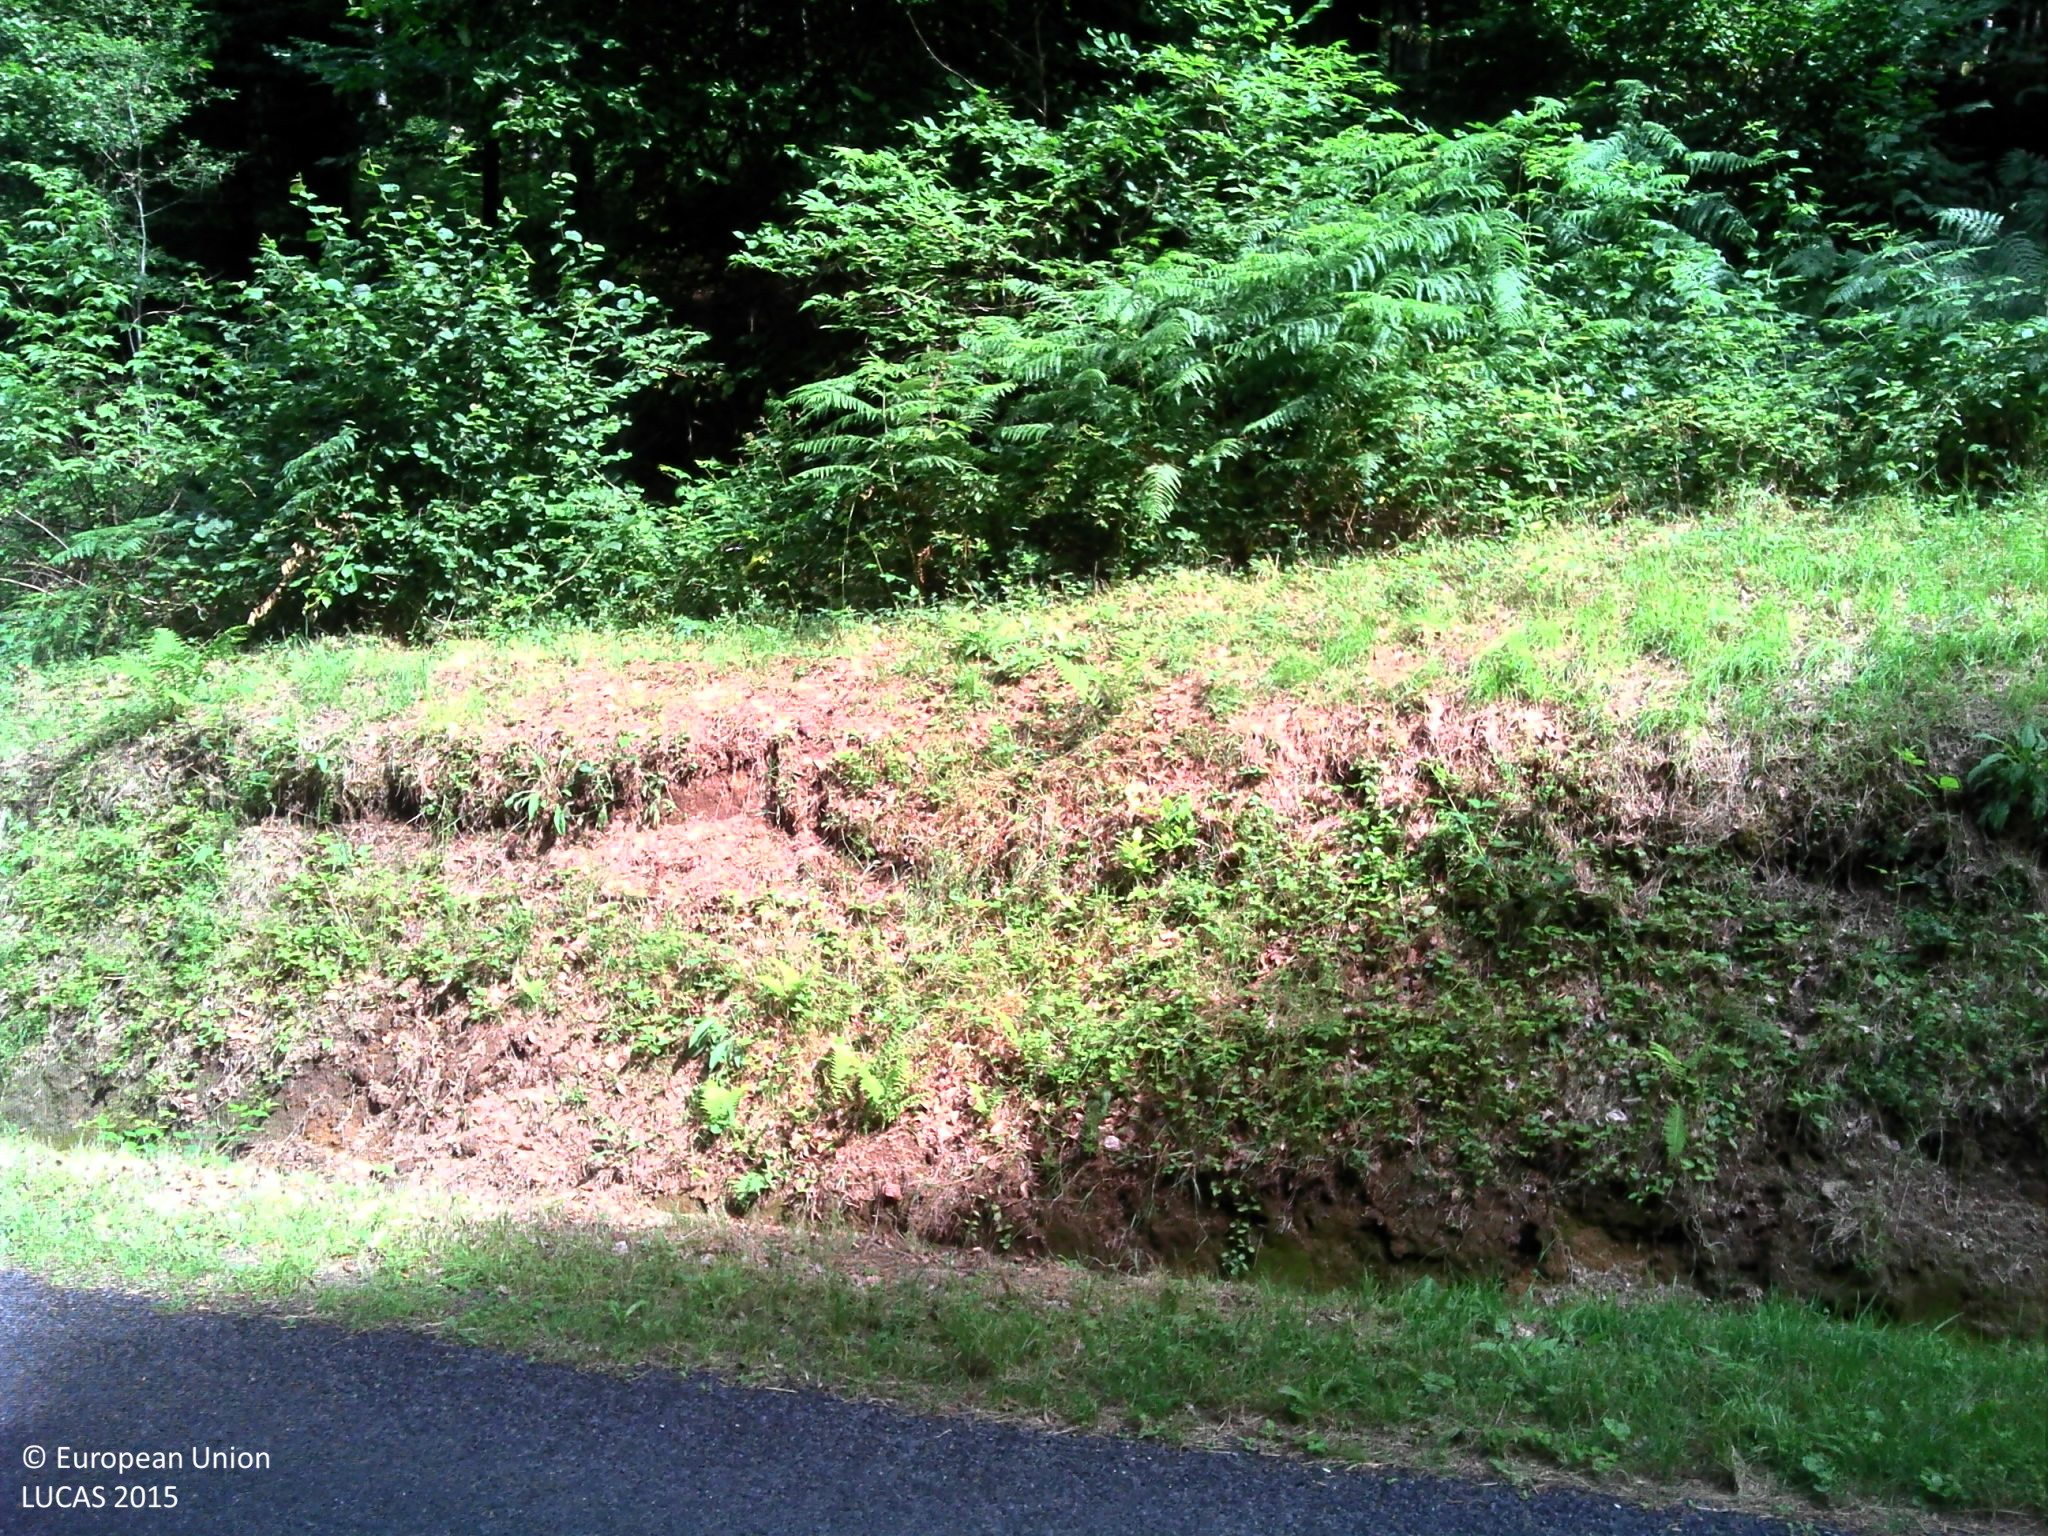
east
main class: Woodland
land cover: Broadleaved woodland
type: beech forest
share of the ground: > 75 %
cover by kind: broadleaved forest trees 70 %, herbaceous plants 25 %, lichens and mosses 5 %
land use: Forestry
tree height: > 5 m
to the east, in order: Broadleaved woodland; Electric lines; Grass margins; Paved roads, cycling and walking lanes; Grass margins; Ditches and canals; Broadleaved woodland
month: July
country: FR
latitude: 45.6593
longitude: 1.8453
